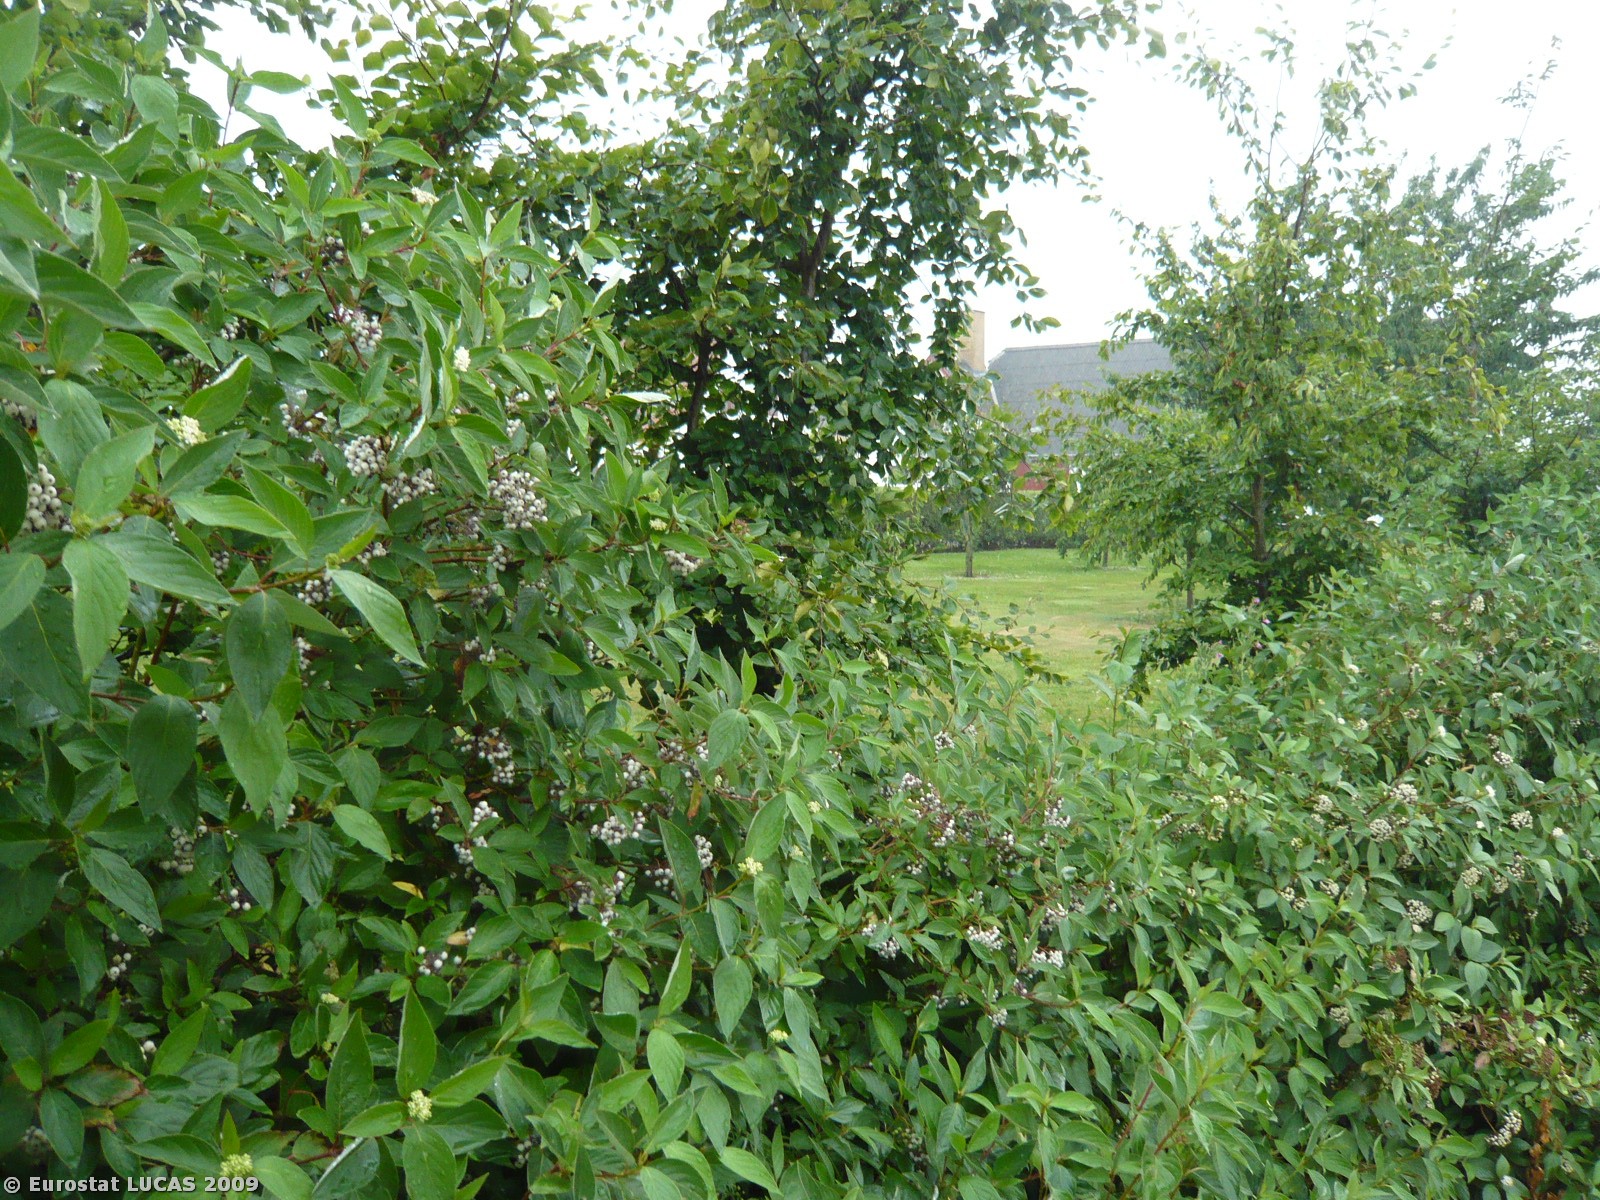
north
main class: Cropland
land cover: Common wheat
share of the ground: > 75 %
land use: Agriculture (excluding fallow land and kitchen gardens)
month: July
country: DK
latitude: 55.7957
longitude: 11.9282
